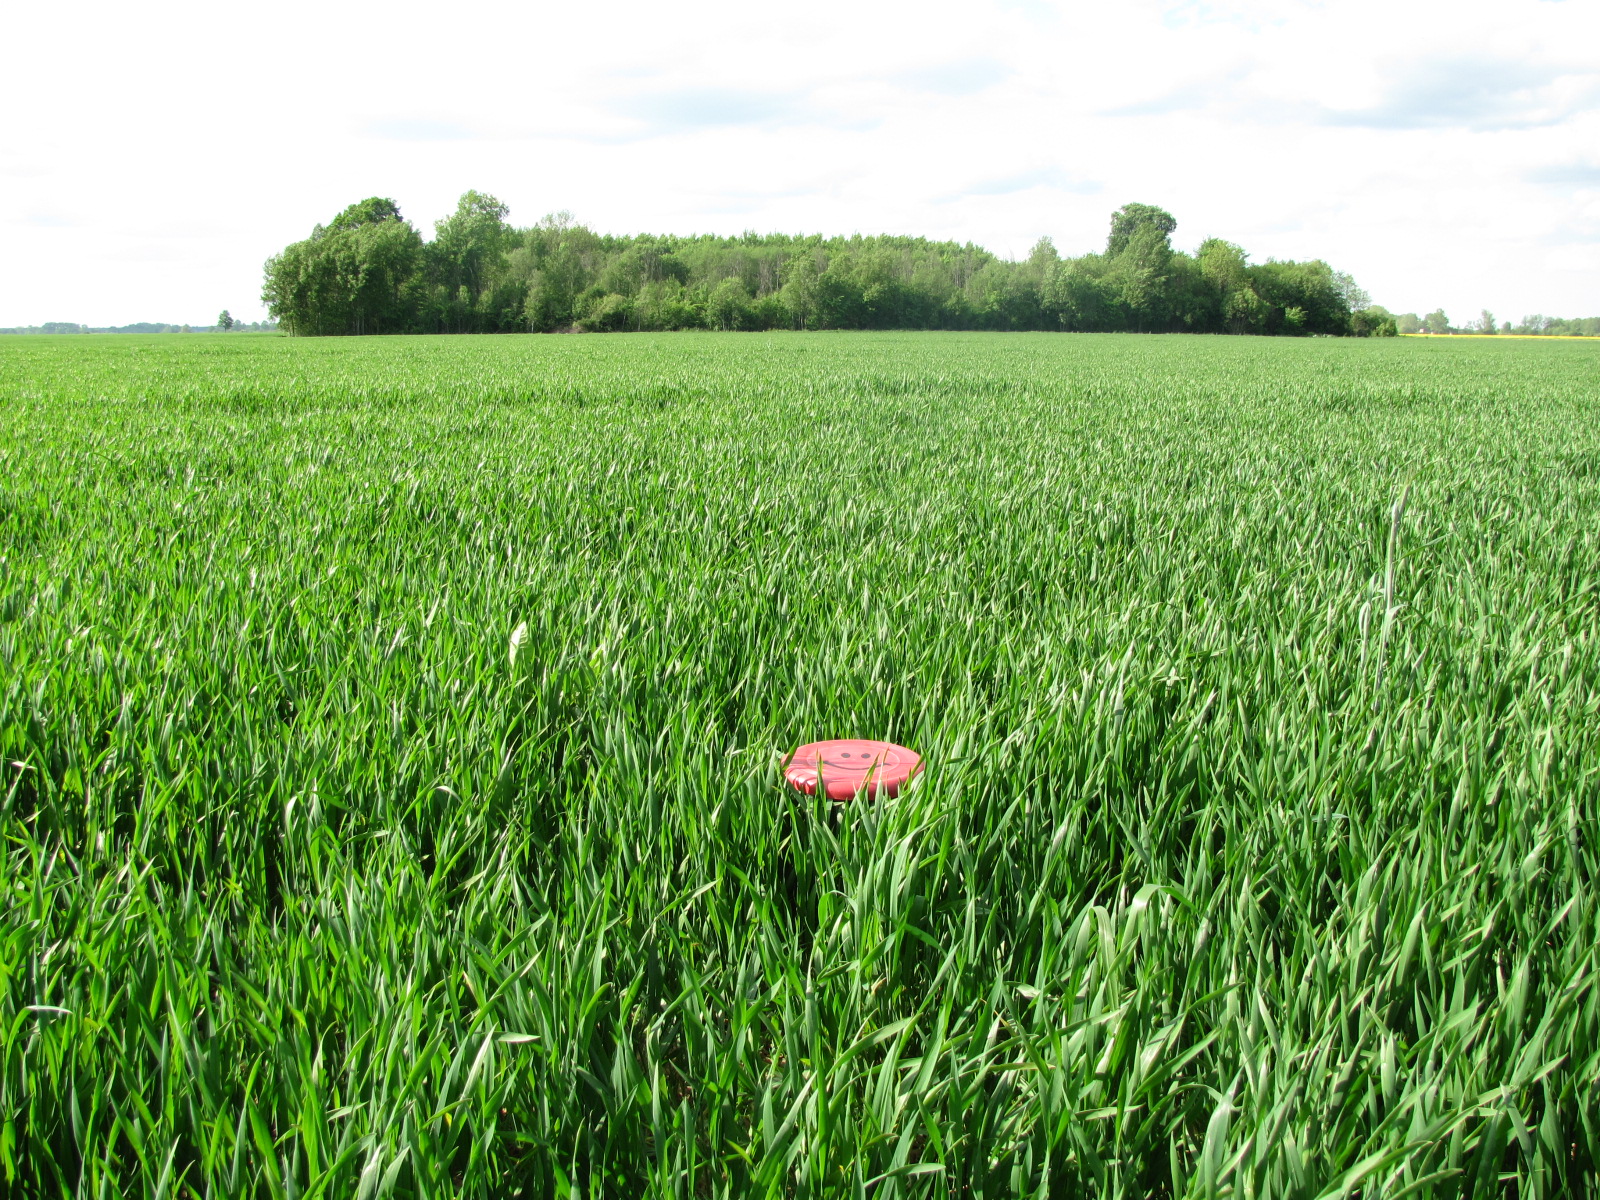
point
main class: Cropland
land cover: Common wheat
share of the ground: > 75 %
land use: Agriculture (excluding fallow land and kitchen gardens)
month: May
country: LV
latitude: 56.5423
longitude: 23.8903
